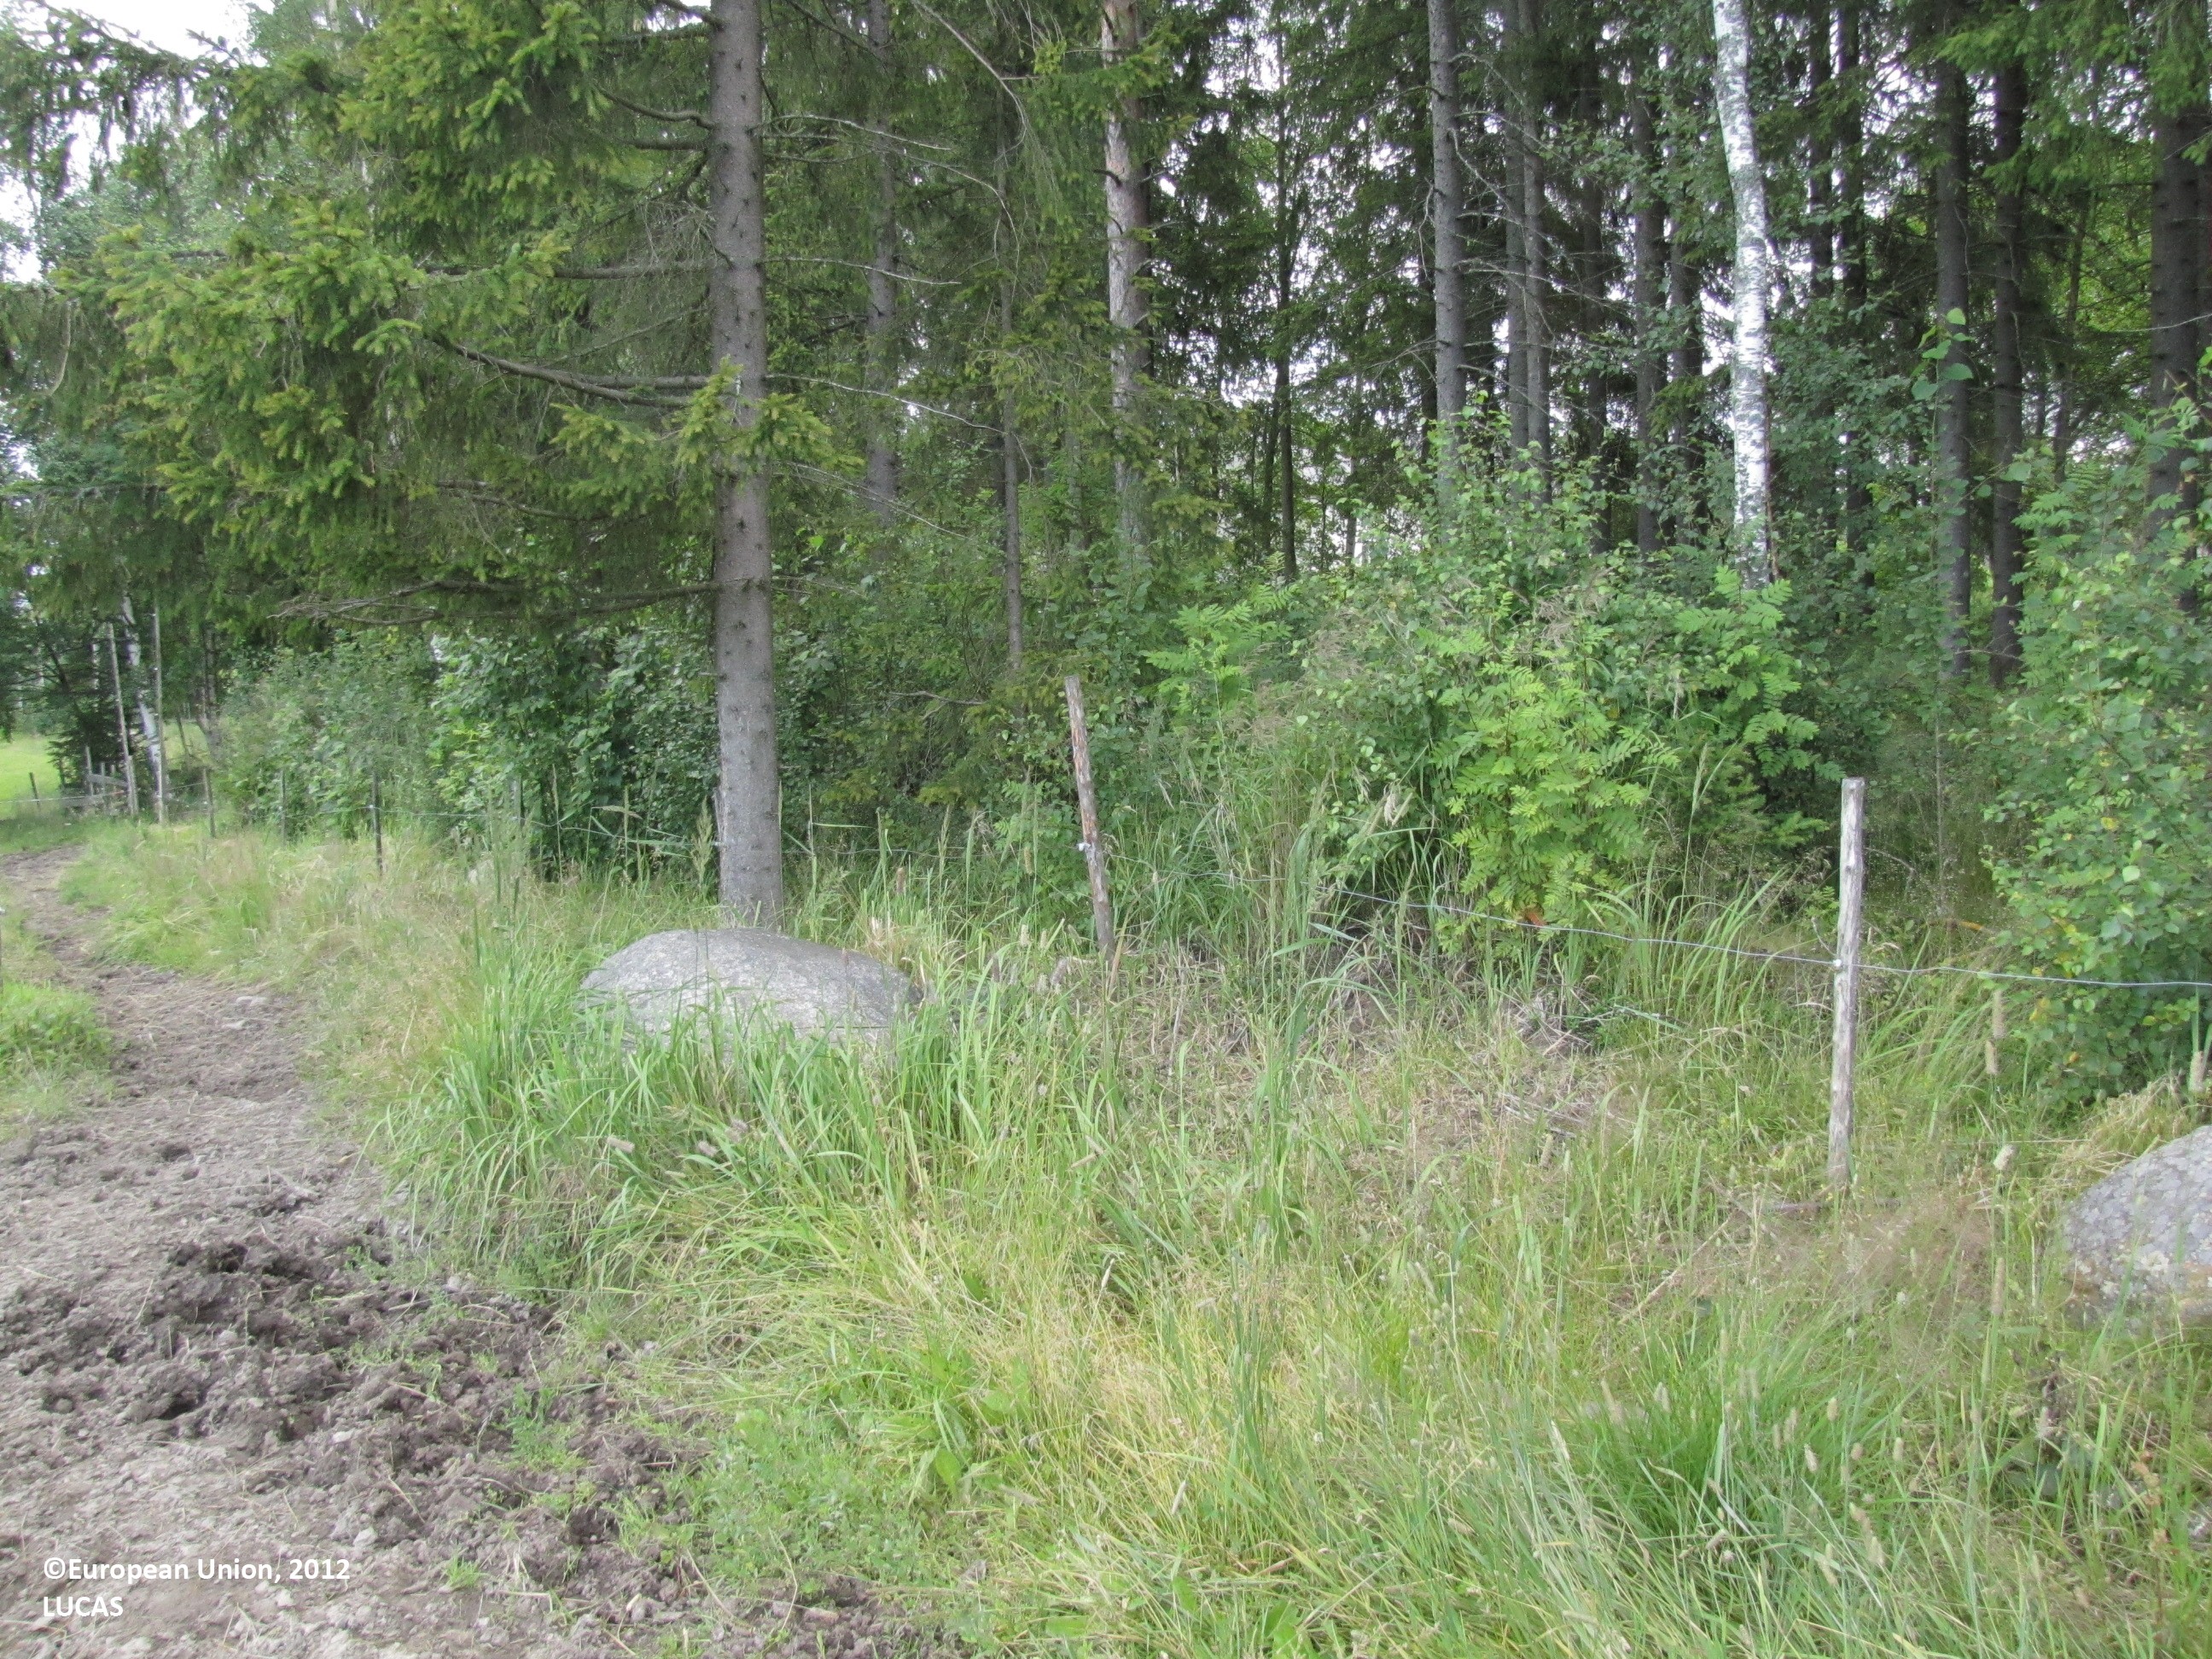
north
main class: Grassland
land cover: Grassland without tree/shrub cover
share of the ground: > 75 %
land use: Agriculture (excluding fallow land and kitchen gardens)
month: July
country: FI
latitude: 62.6204
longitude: 23.3409
